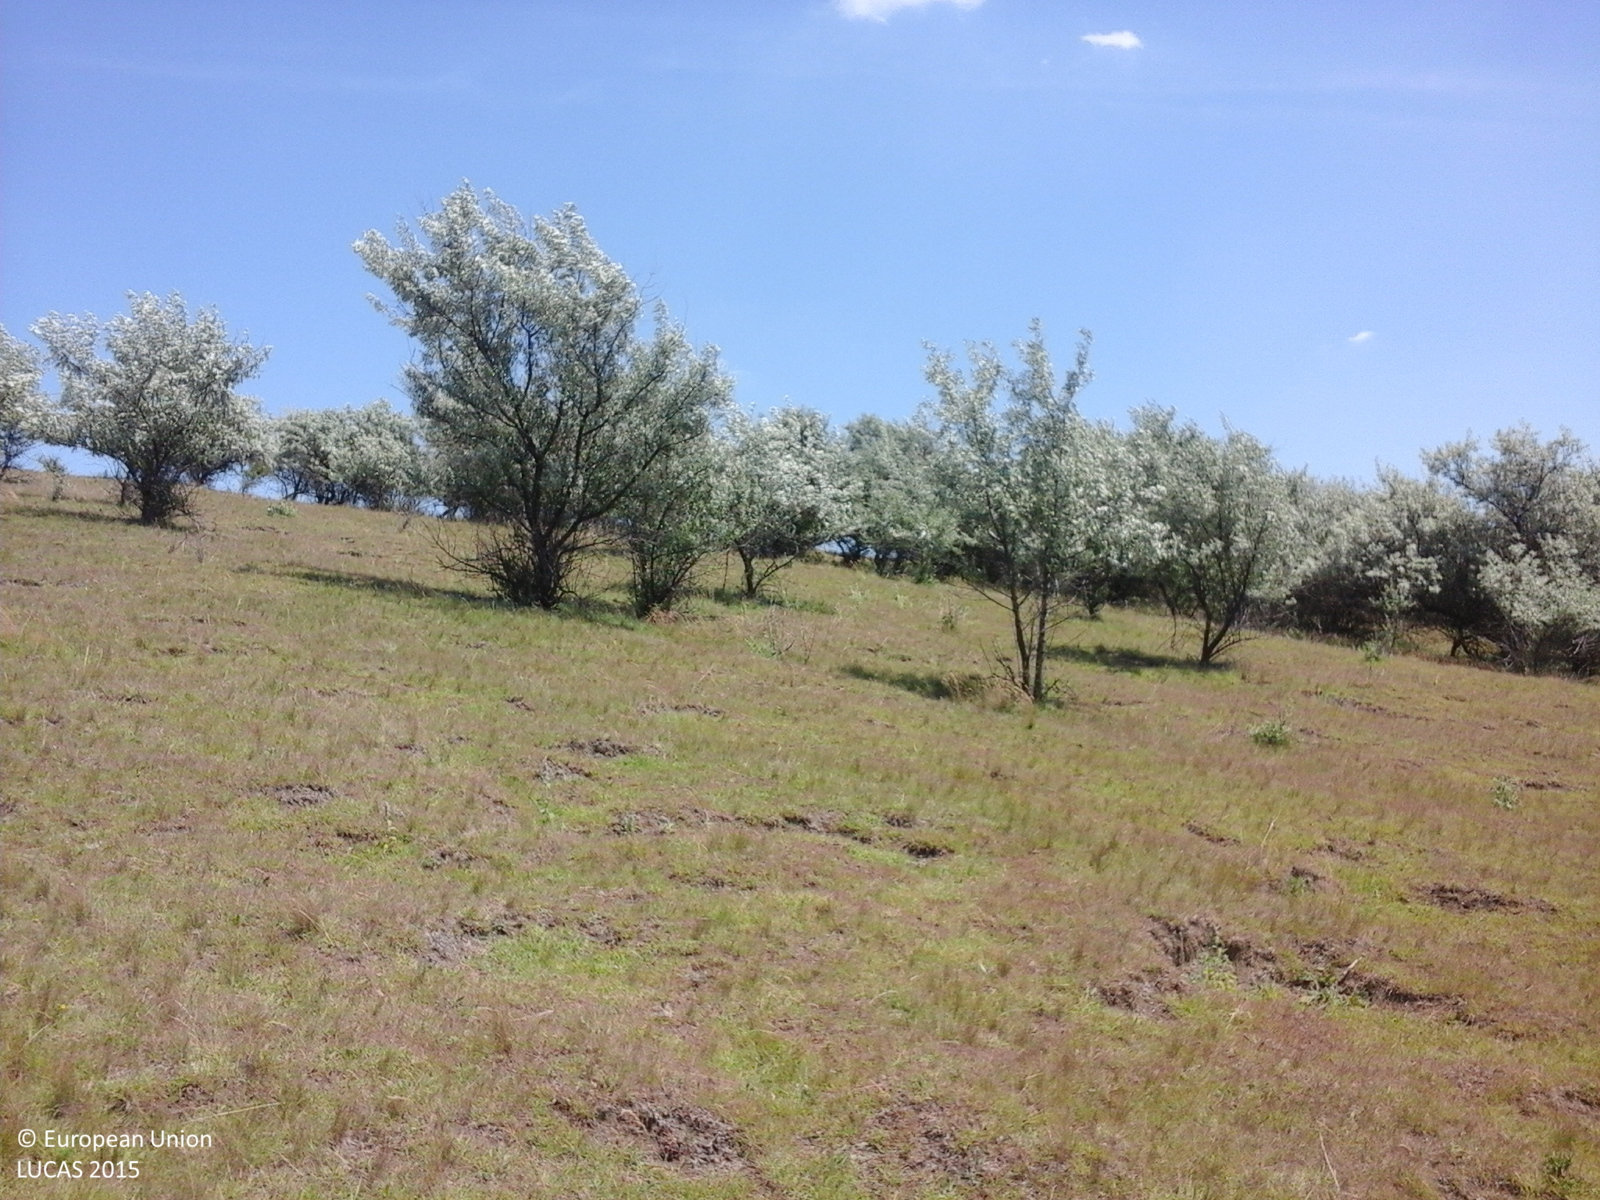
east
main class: Grassland
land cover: Grassland without tree/shrub cover
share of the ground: > 75 %
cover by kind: herbaceous plants 100 %
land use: Agriculture (excluding fallow land and kitchen gardens)
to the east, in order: Grassland without tree/shrub cover; Broadleaved woodland; Grassland without tree/shrub cover; Tracks; Common wheat; Rape and turnip rape
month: June
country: RO
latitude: 48.1463
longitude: 26.7252
